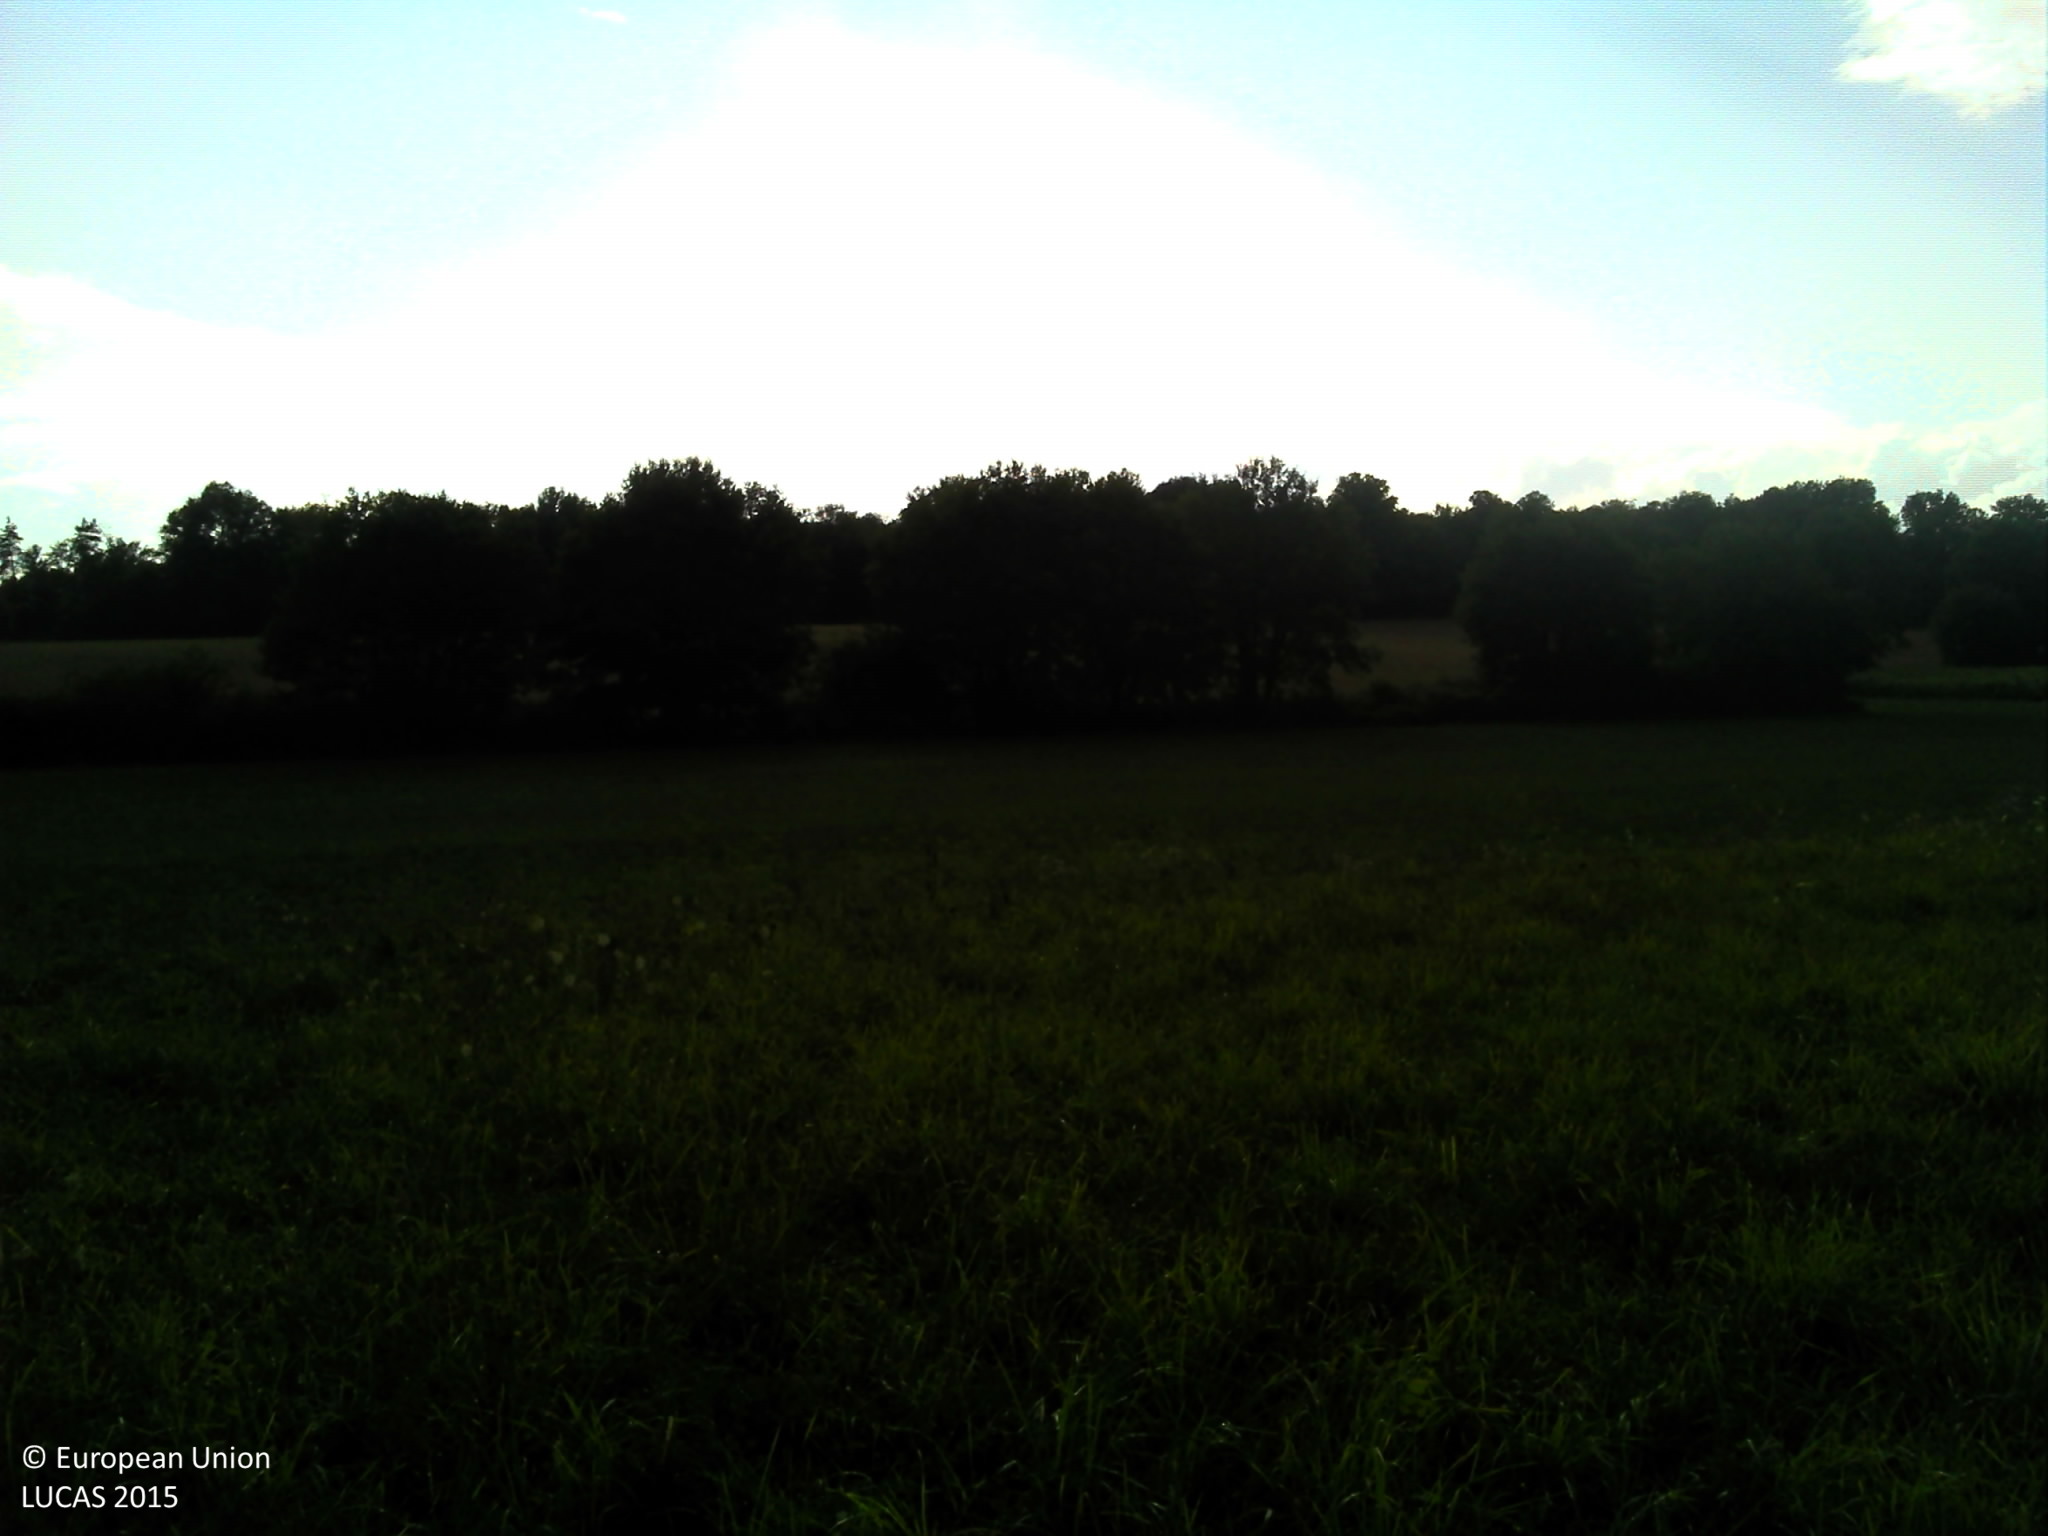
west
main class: Grassland
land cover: Grassland without tree/shrub cover
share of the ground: > 75 %
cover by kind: herbaceous plants 100 %
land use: Agriculture (excluding fallow land and kitchen gardens)
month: August
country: FR
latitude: 45.3993
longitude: 0.6759
